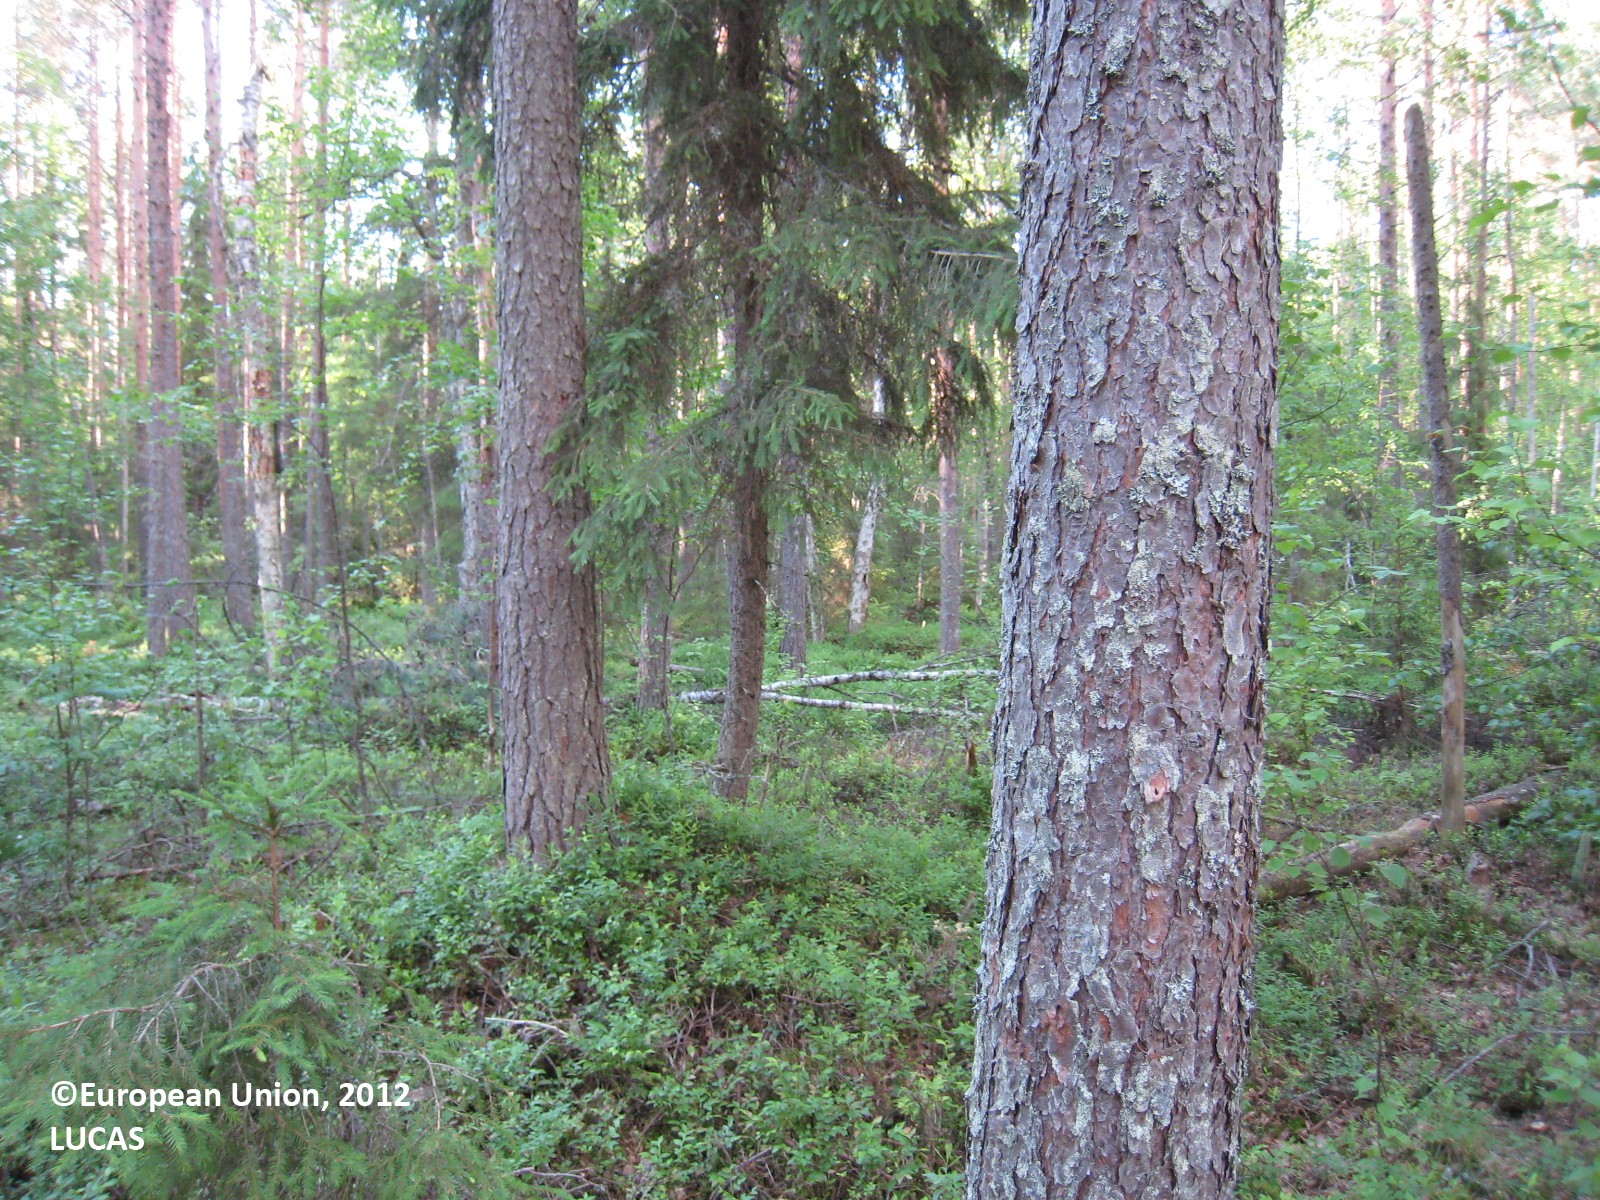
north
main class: Woodland
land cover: Pine dominated mixed woodland
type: boreal forest
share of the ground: 50 - 75 %
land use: Forestry
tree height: > 5 m
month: June
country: FI
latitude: 62.0120
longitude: 26.1199
